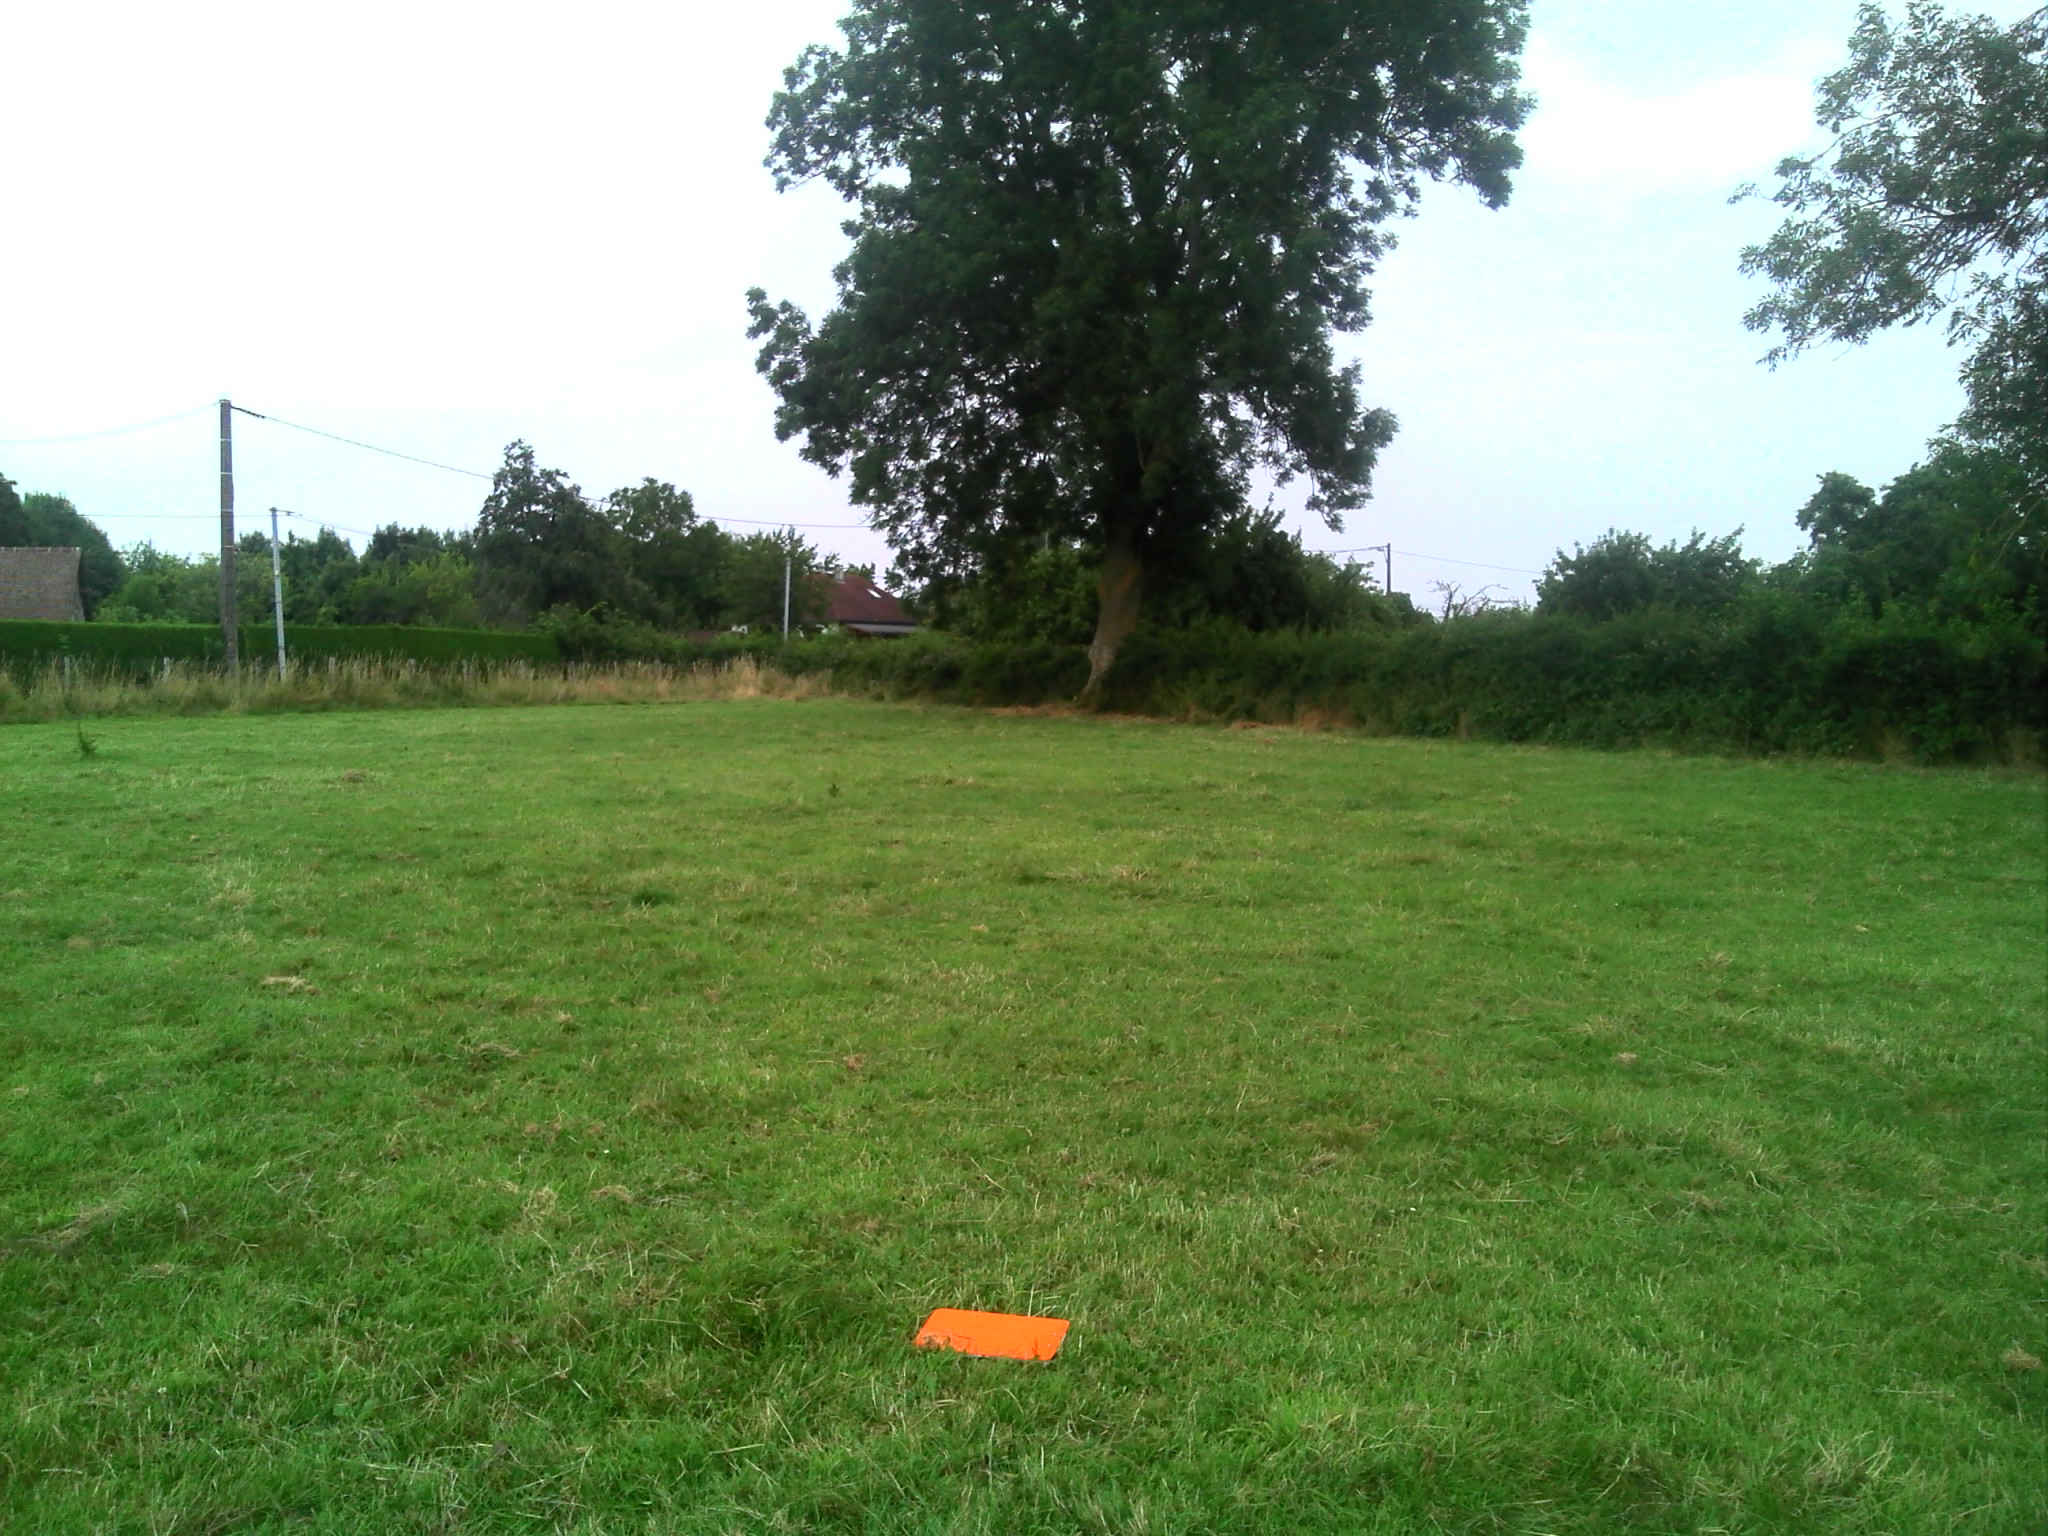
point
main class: Grassland
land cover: Grassland without tree/shrub cover
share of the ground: > 75 %
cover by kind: herbaceous plants 100 %
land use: Agriculture (excluding fallow land and kitchen gardens)
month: July
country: FR
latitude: 49.0419
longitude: 0.6867
